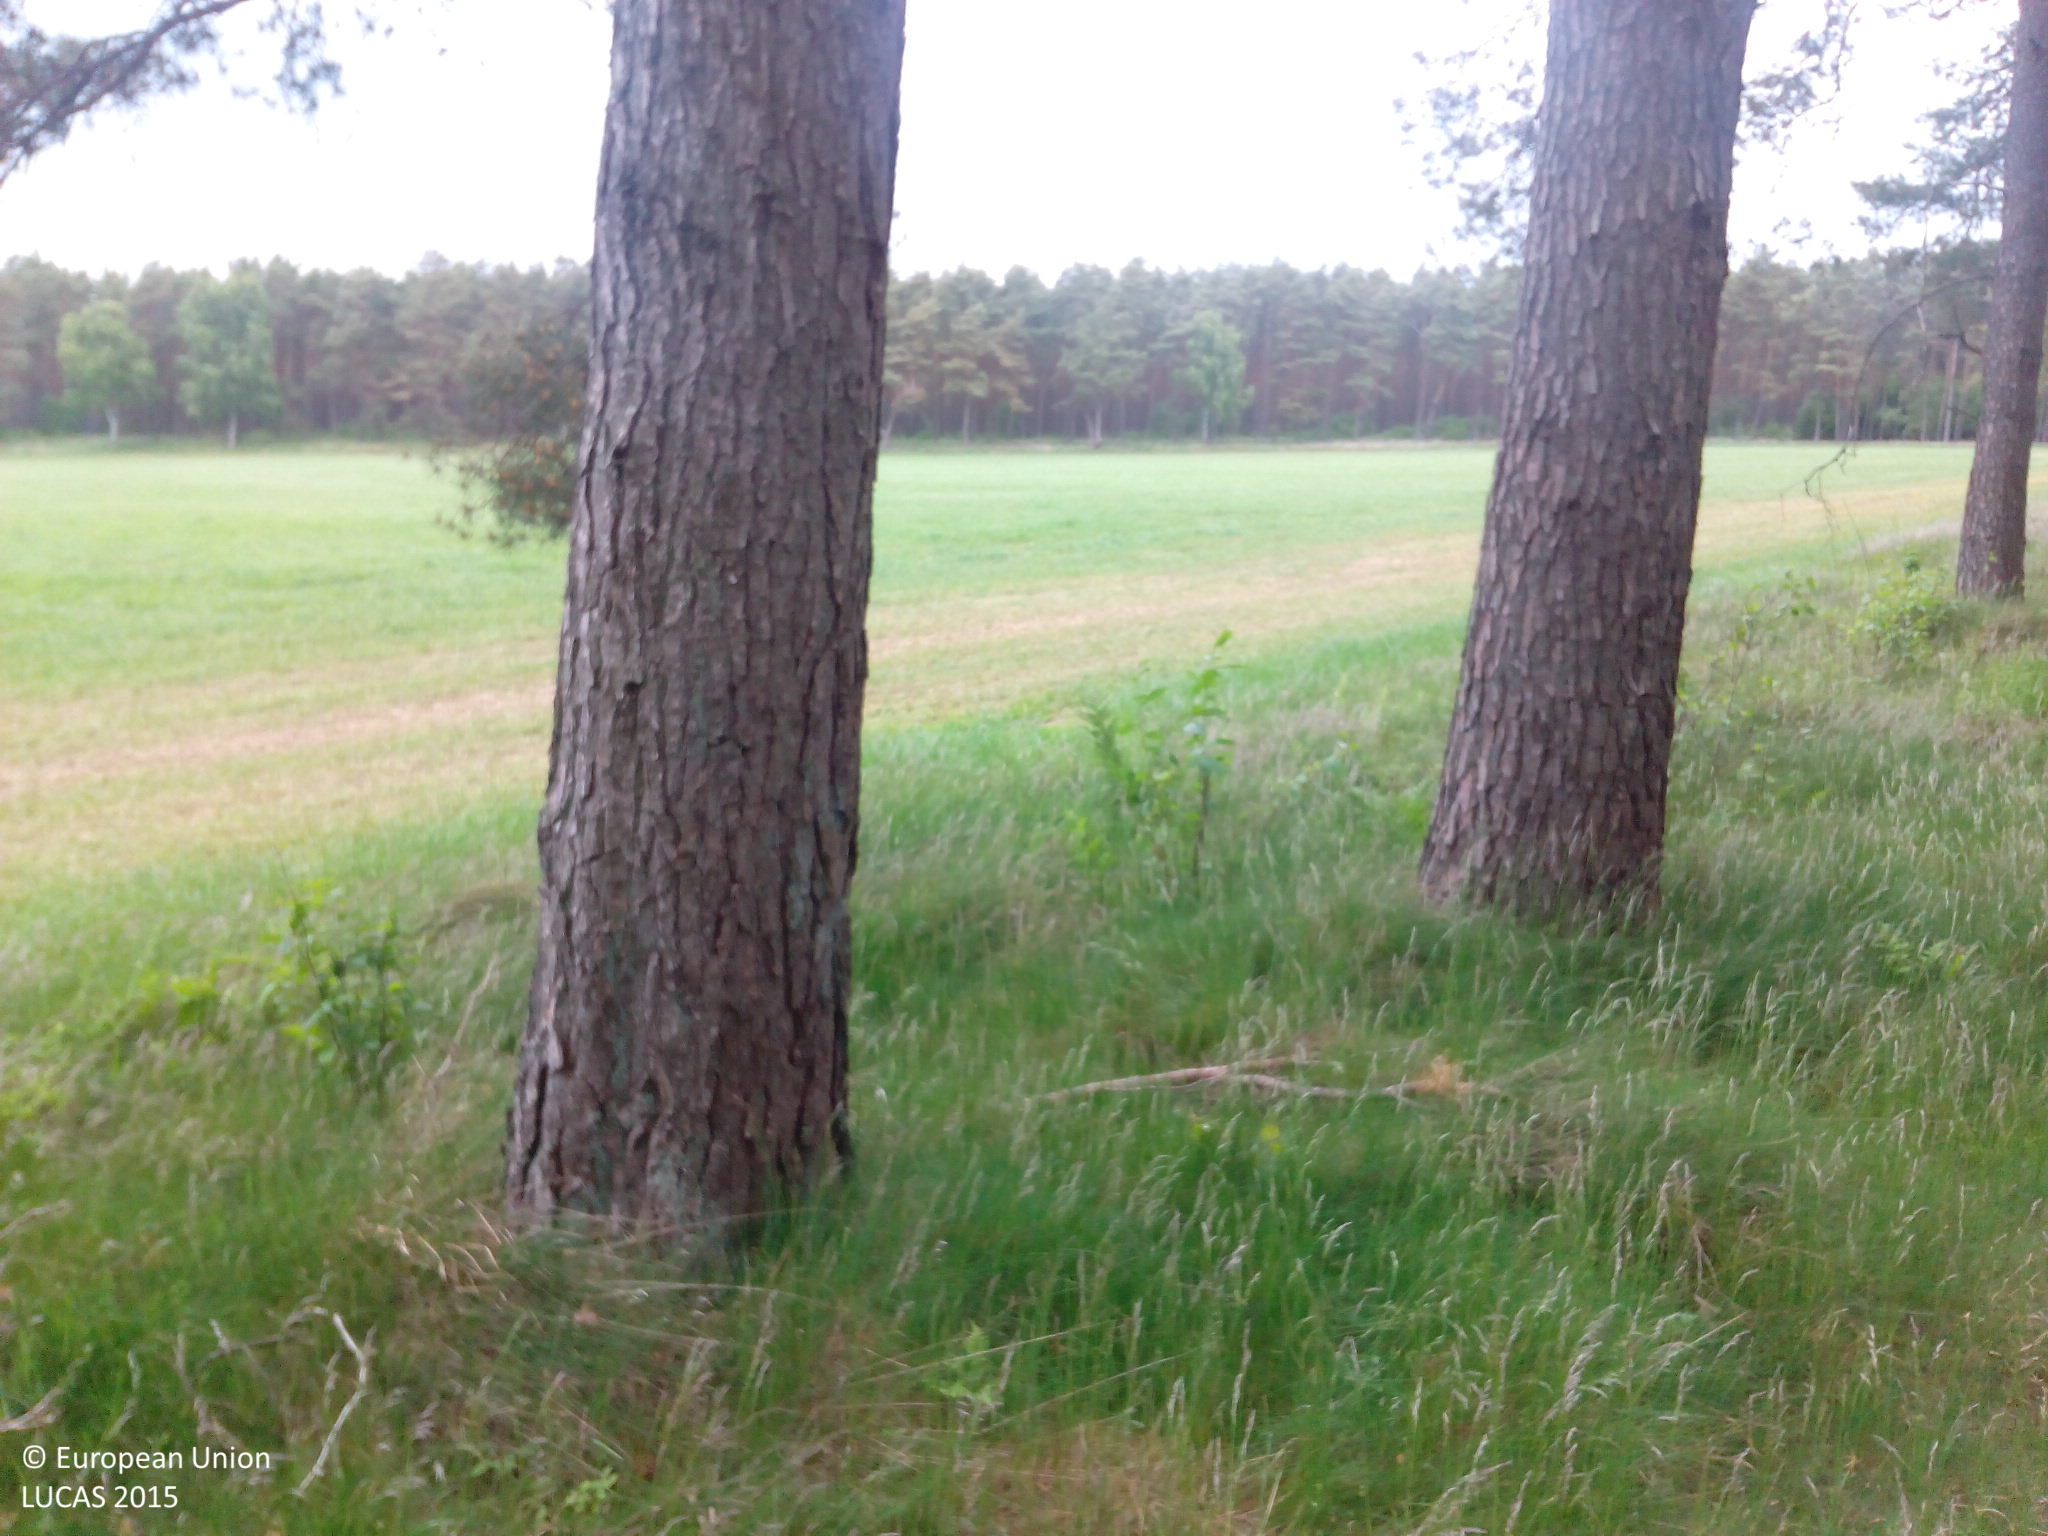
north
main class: Woodland
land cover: Pine dominated coniferous woodland
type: hemiboreal forest and nemoral coniferous forest and mixed broadleaved-coniferous forest
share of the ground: > 75 %
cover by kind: coniferous forest trees 85 %, herbaceous plants 10 %, shrubs 5 %
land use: Forestry
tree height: > 5 m
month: June
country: DE
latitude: 53.3010
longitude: 11.6349
